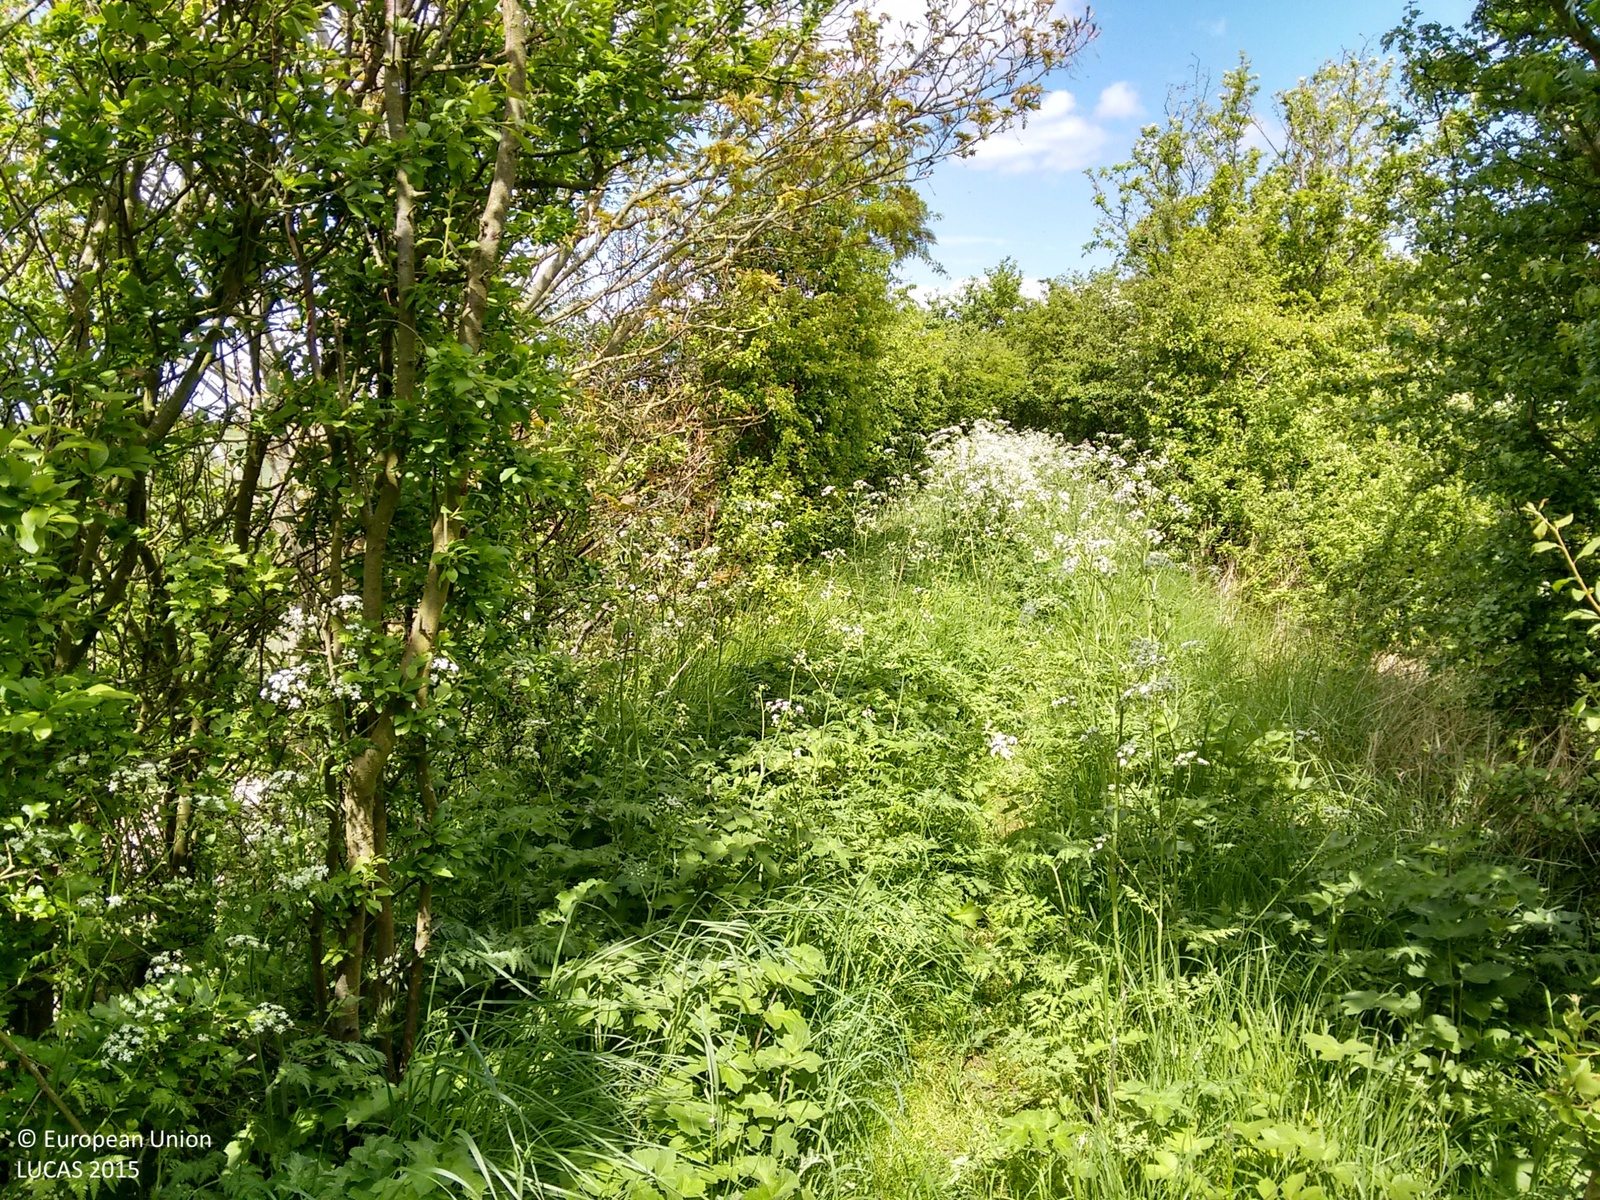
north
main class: Woodland
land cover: Broadleaved woodland
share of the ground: 10 - 25 %
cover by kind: herbaceous plants 80 %, broadleaved forest trees 20 %
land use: Semi-natural and natural areas not in use
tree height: < 5 m
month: May
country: GB
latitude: 52.9339
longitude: 0.0146
